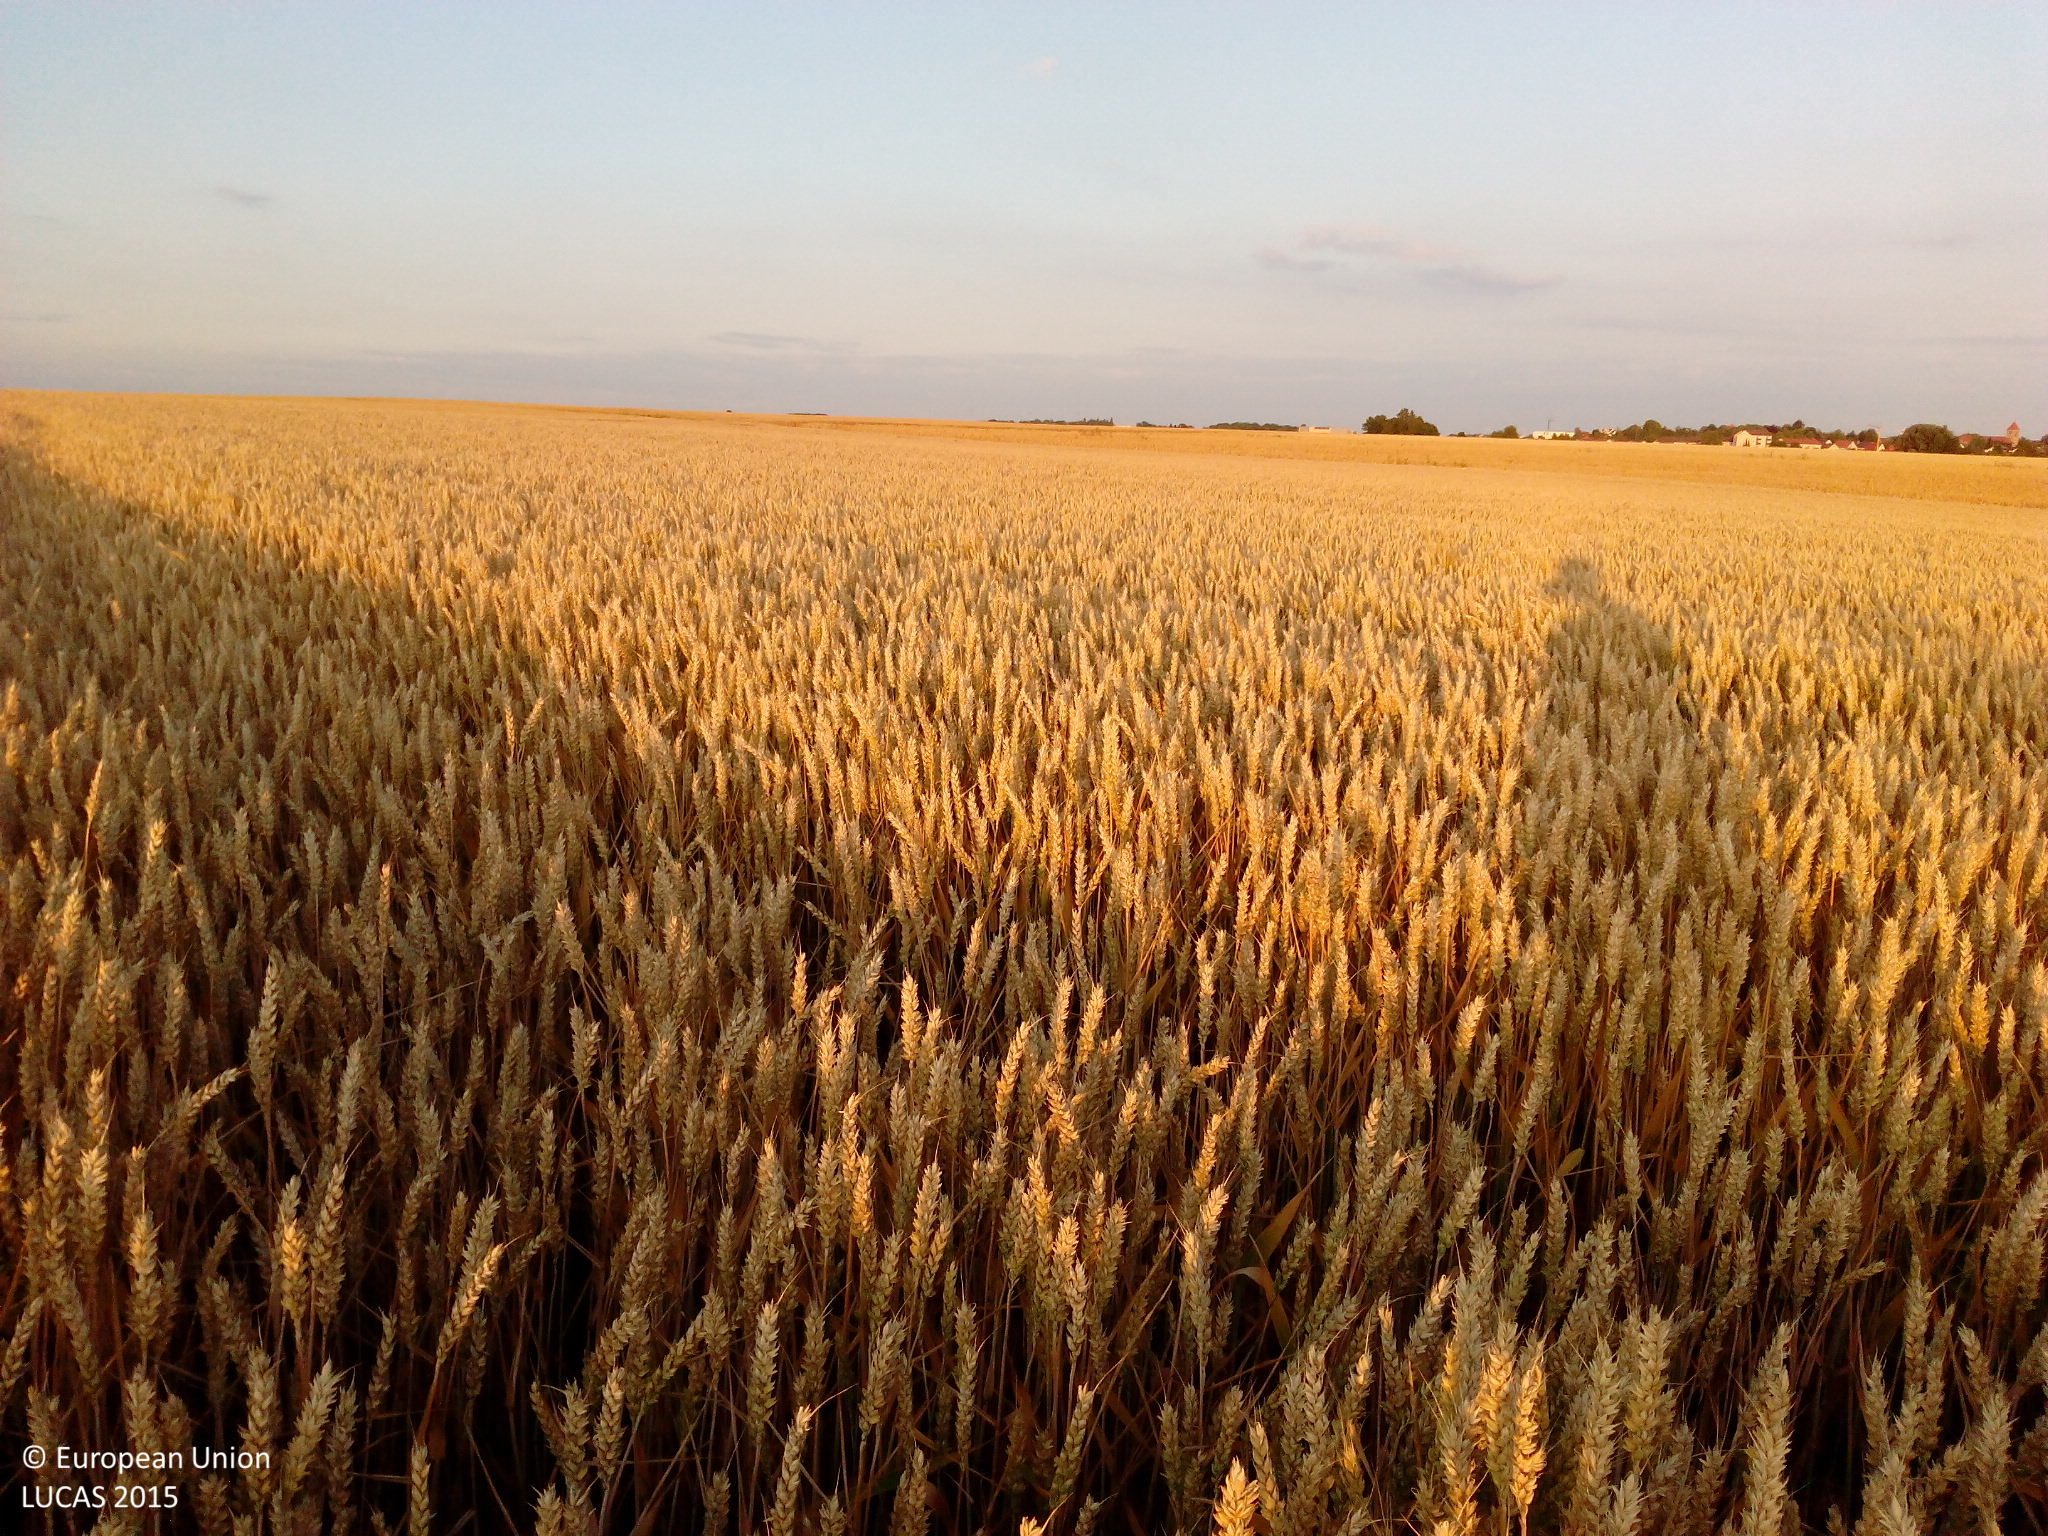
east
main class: Cropland
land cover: Common wheat
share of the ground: > 75 %
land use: Agriculture (excluding fallow land and kitchen gardens)
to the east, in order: Common wheat; Tracks; Common wheat; Grass margins; Paved roads, cycling and walking lanes; Grass margins; Common wheat
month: July
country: DE
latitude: 49.6627
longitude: 9.9308
